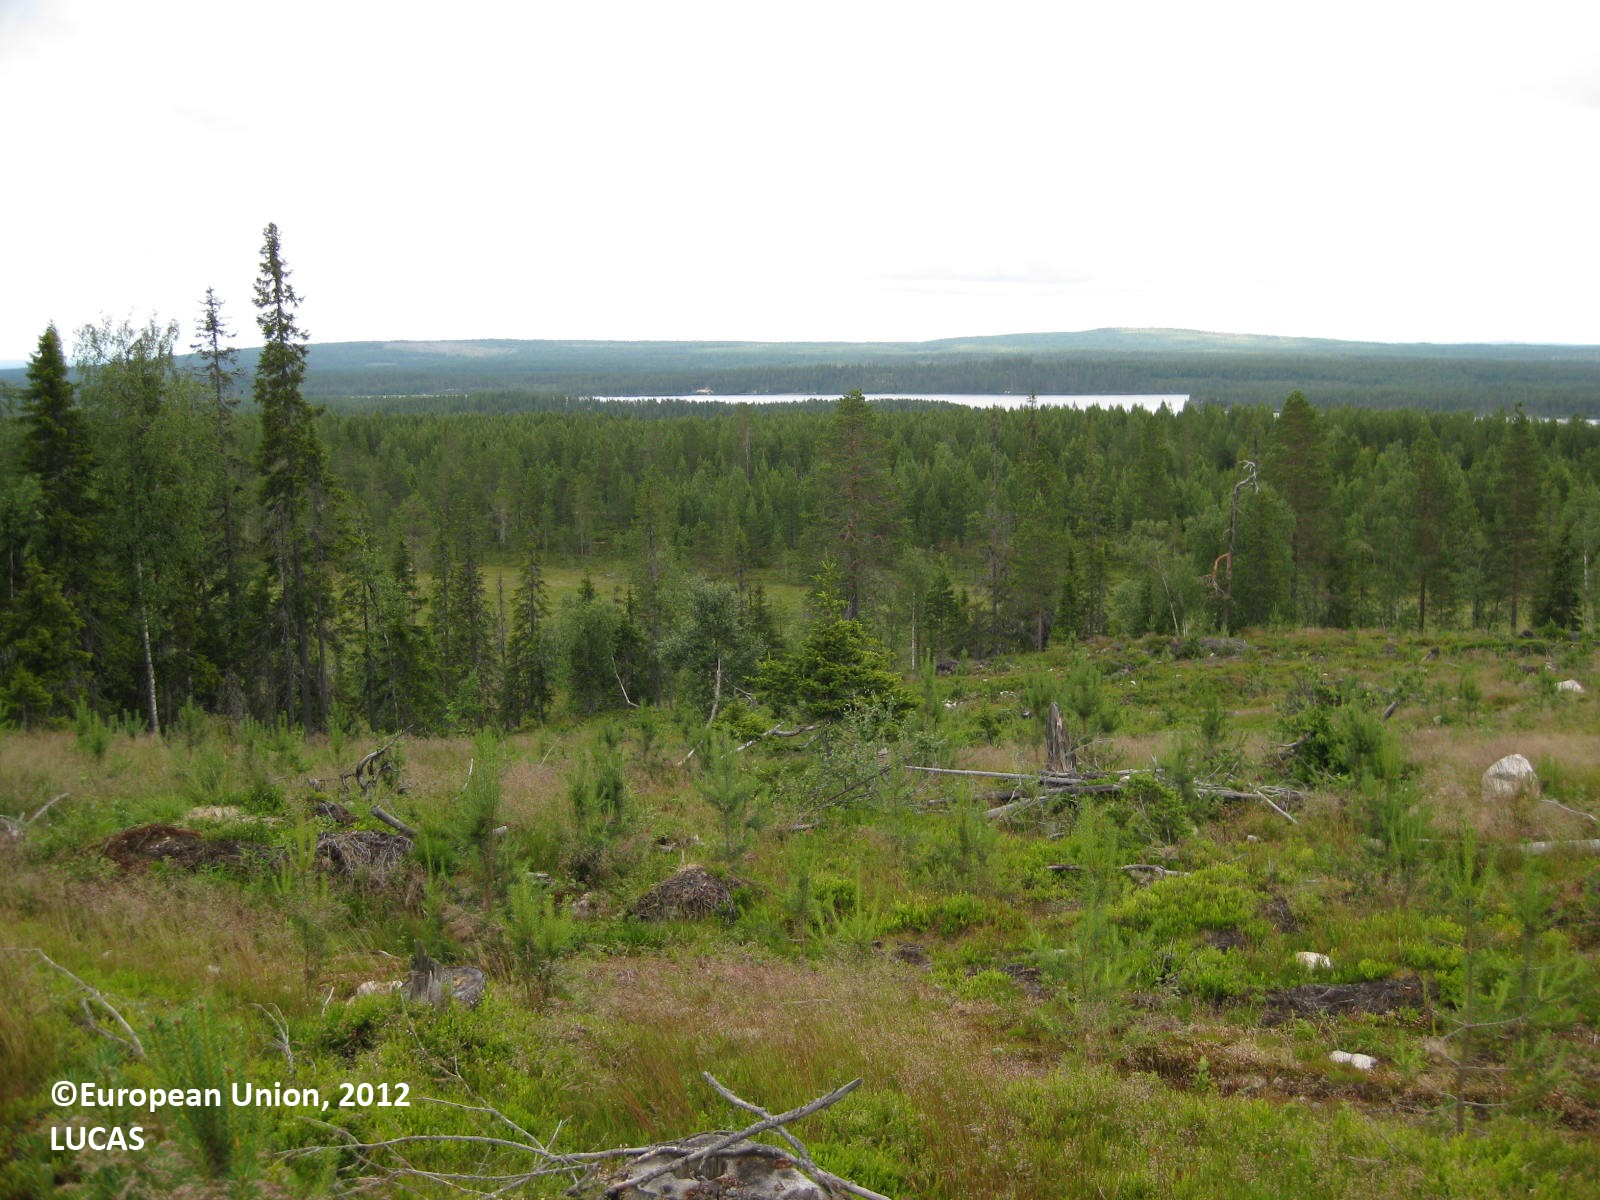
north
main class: Woodland
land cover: Pine dominated coniferous woodland
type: boreal forest
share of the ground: 10 - 25 %
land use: Forestry
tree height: < 5 m
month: July
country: FI
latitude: 65.8107
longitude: 29.3696
